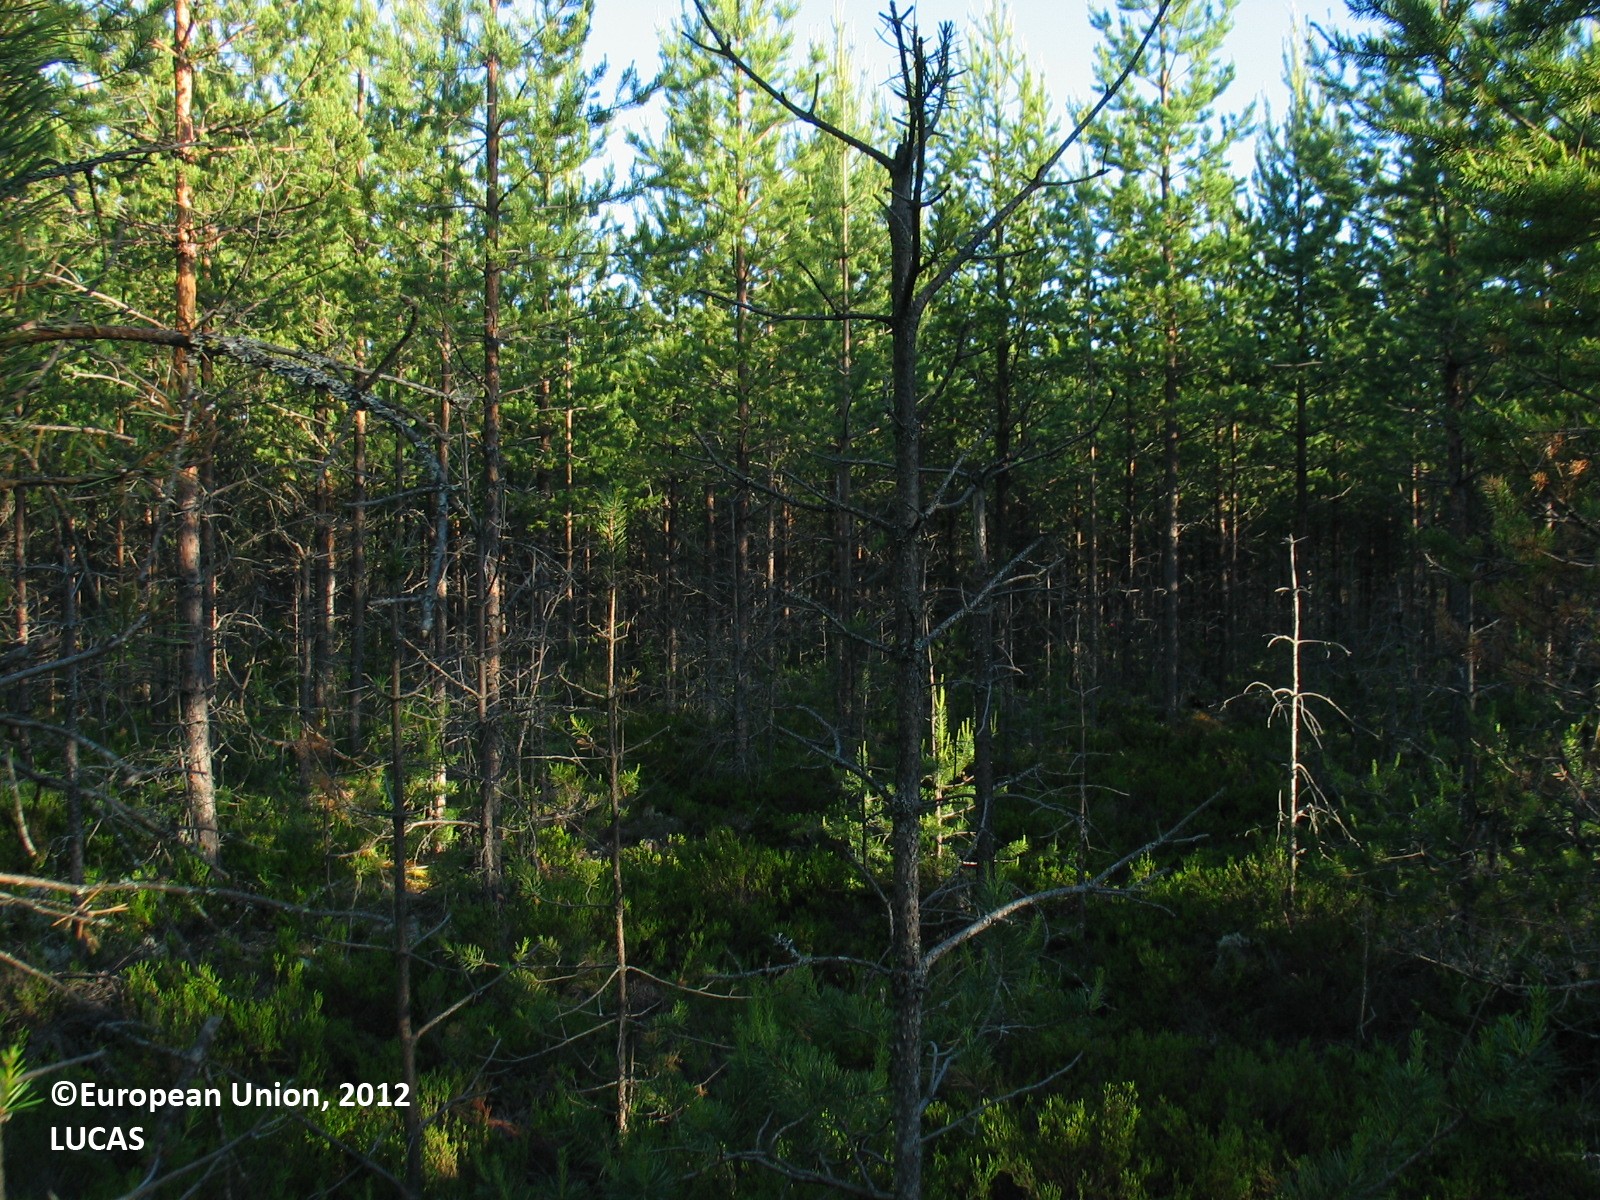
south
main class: Woodland
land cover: Pine dominated coniferous woodland
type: boreal forest
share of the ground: 25 - 50 %
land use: Forestry
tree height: > 5 m
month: July
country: FI
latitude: 64.7955
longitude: 26.5922
